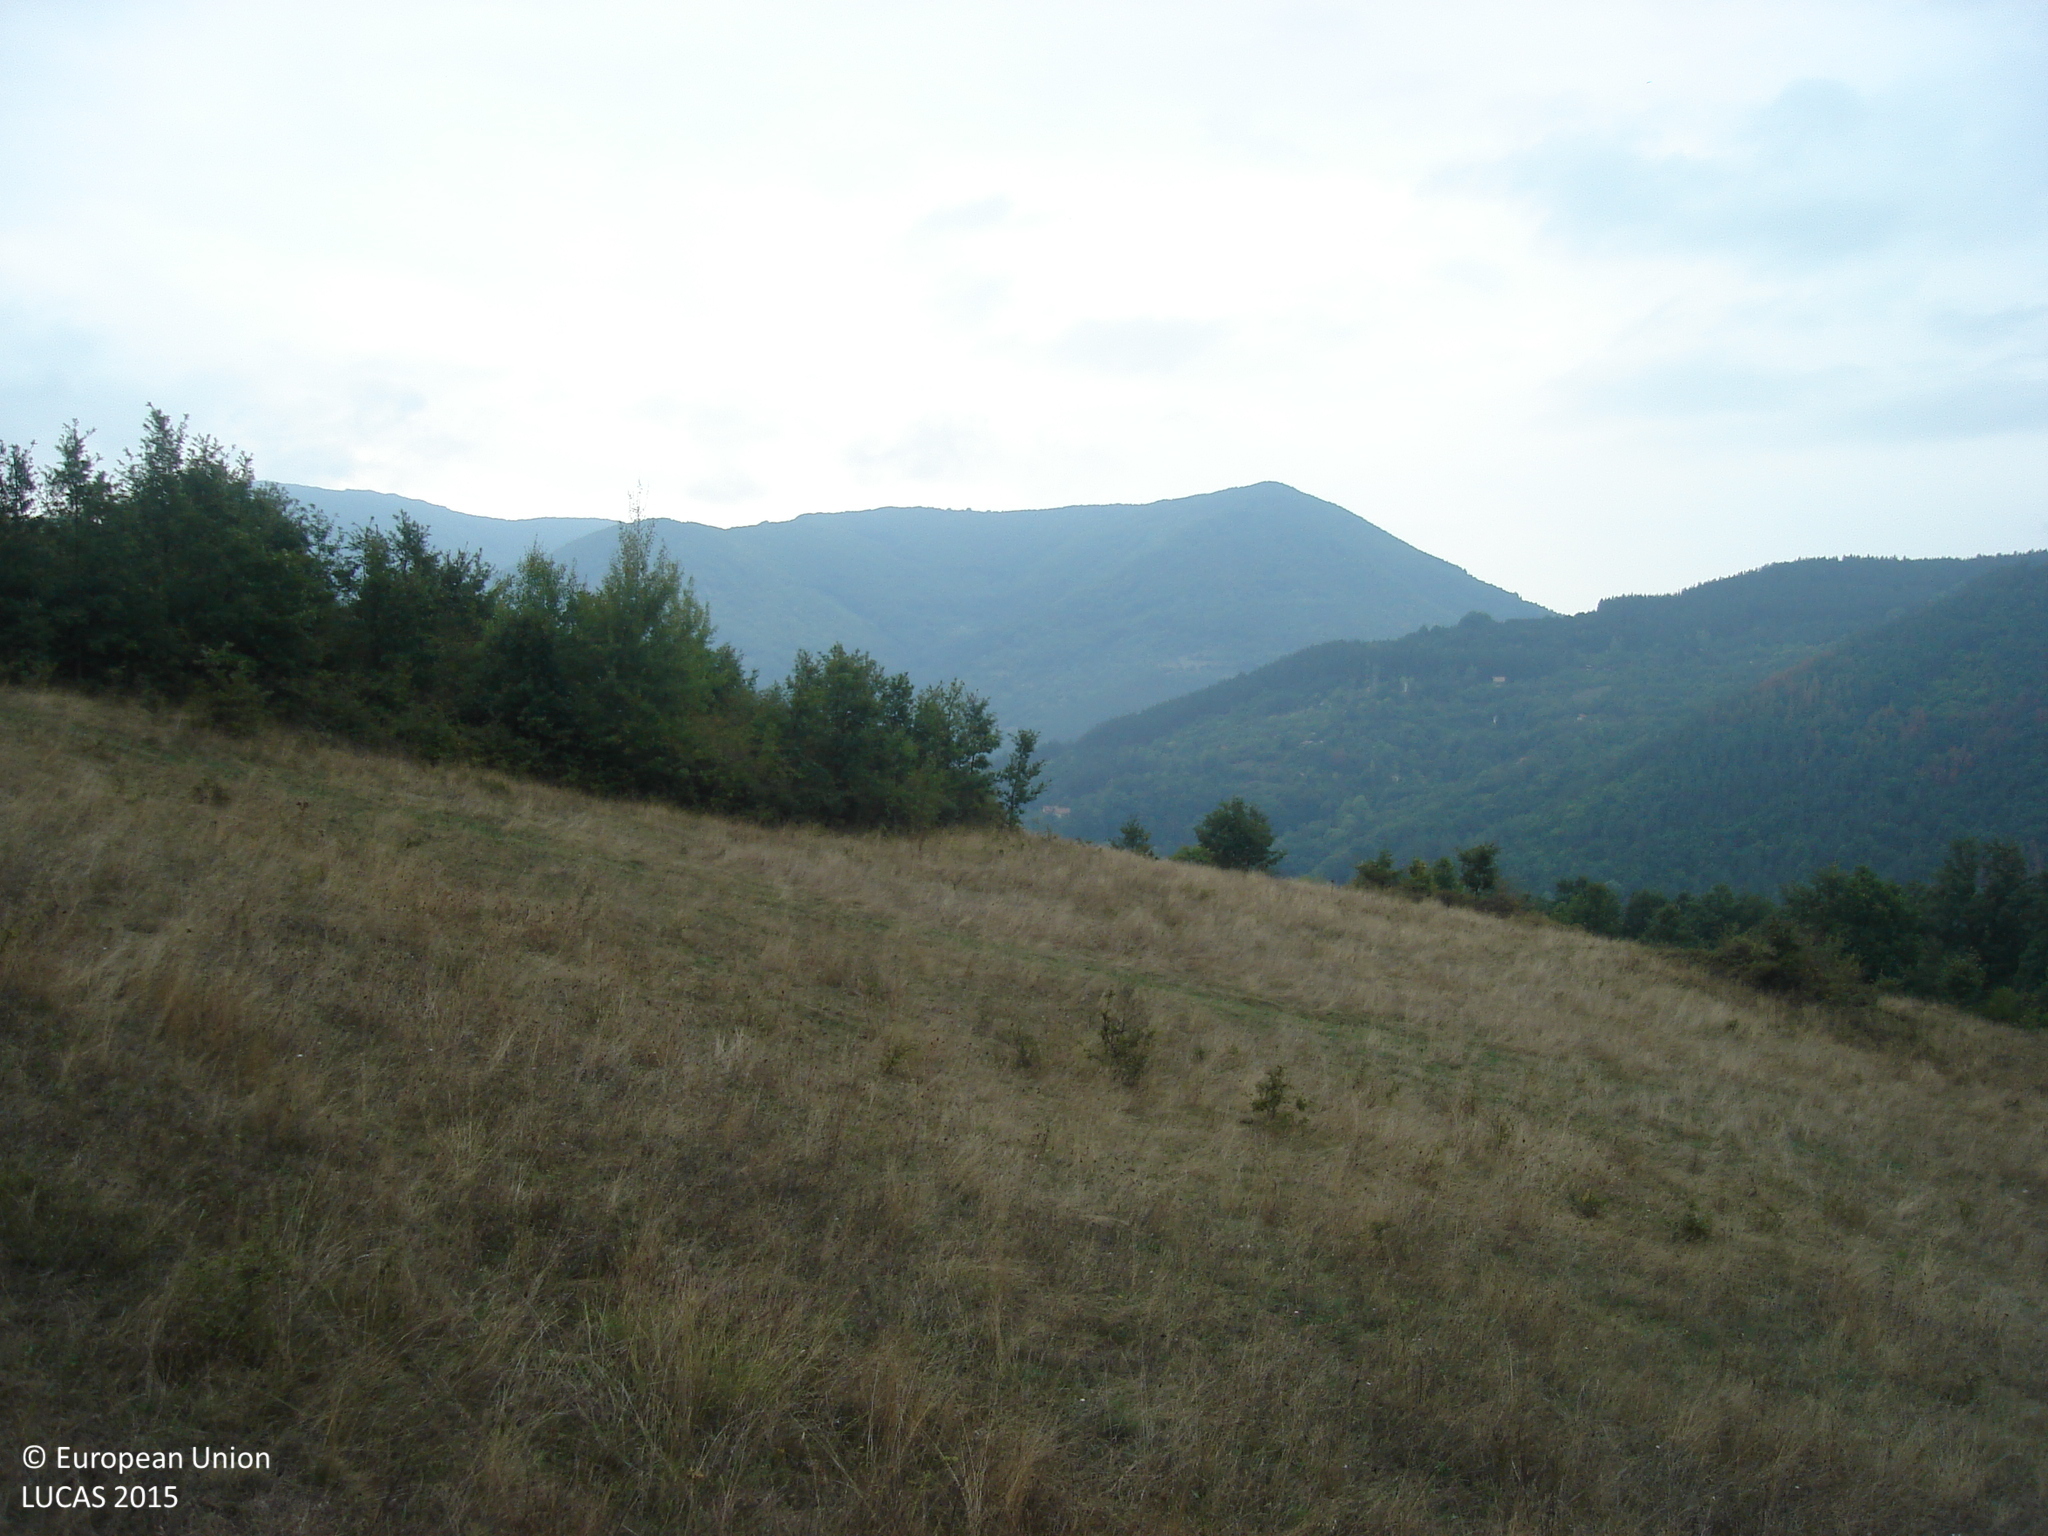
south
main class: Grassland
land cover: Grassland with sparse tree/shrub cover
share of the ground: > 75 %
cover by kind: herbaceous plants 85 %, shrubs 10 %, broadleaved forest trees 5 %
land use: Semi-natural and natural areas not in use
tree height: < 5 m
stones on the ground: < 10 %
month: September
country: BG
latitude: 42.9796
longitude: 23.2926
